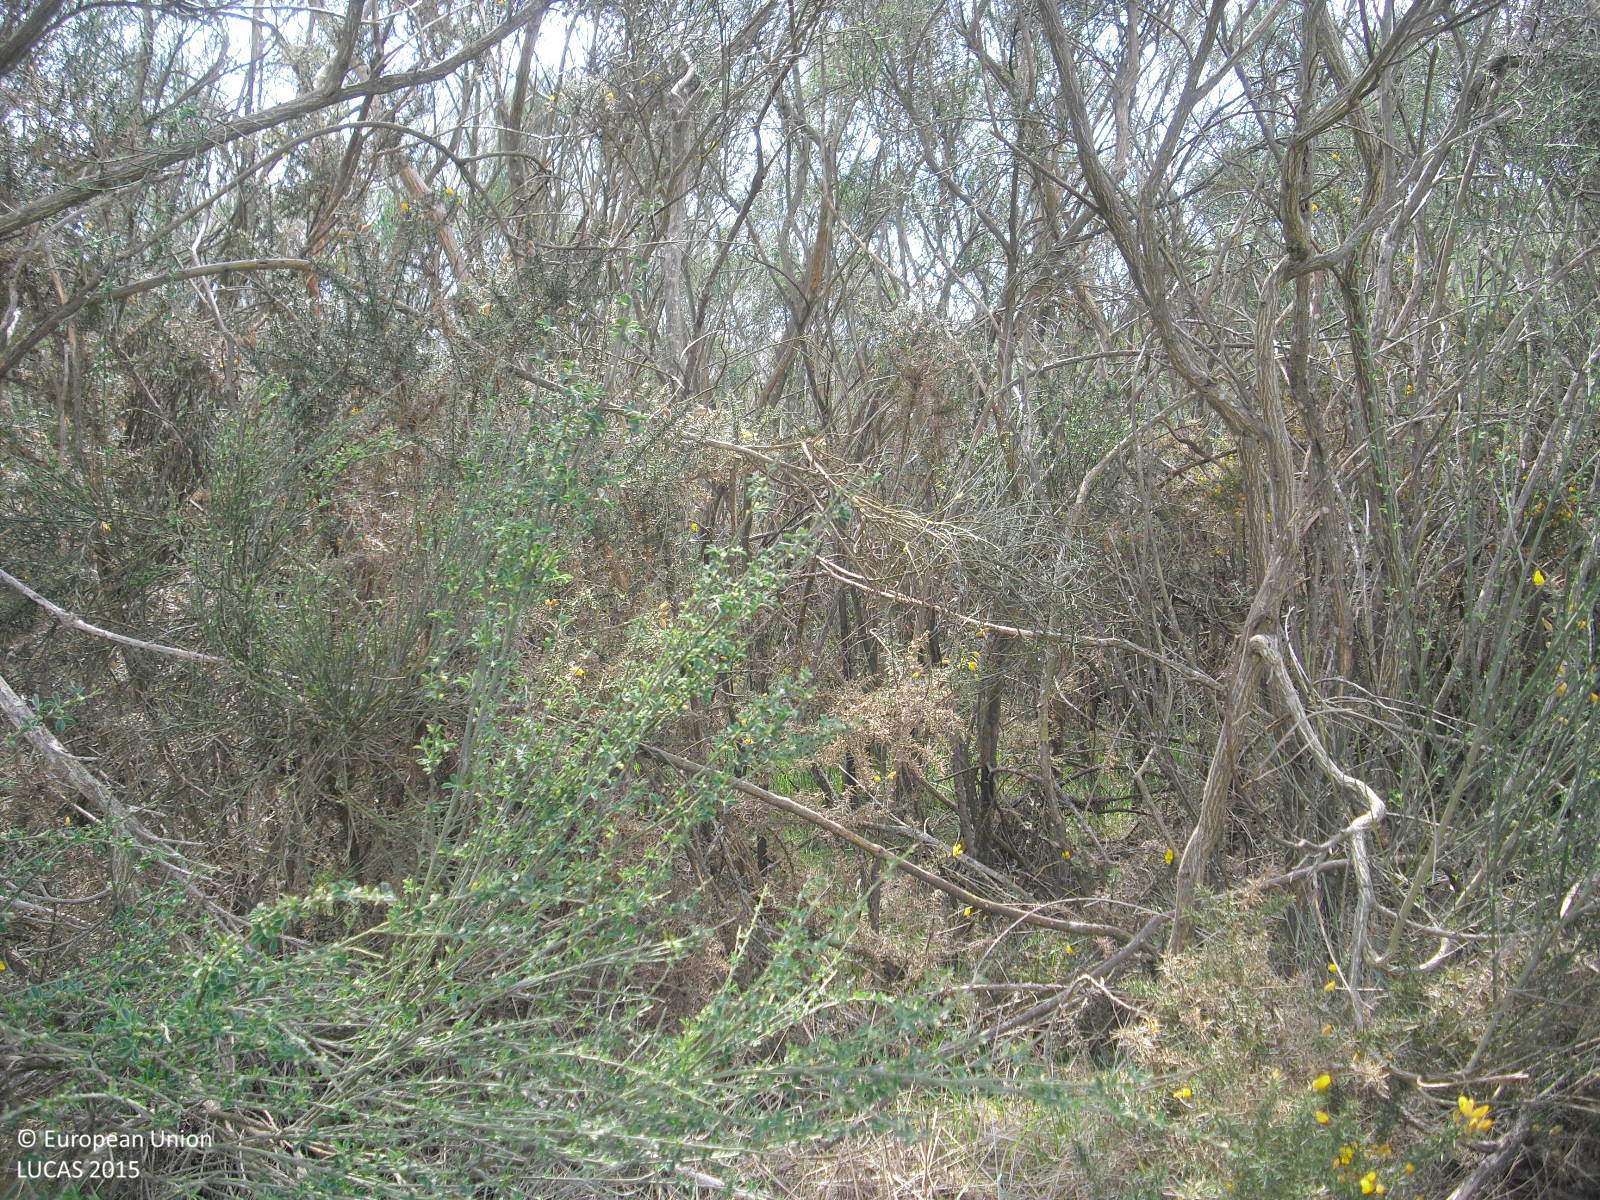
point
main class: Shrubland
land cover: Shrubland without tree cover
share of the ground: > 75 %
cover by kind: shrubs 90 %, herbaceous plants 10 %
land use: Semi-natural and natural areas not in use
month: April
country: ES
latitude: 41.9846
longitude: -7.8011
